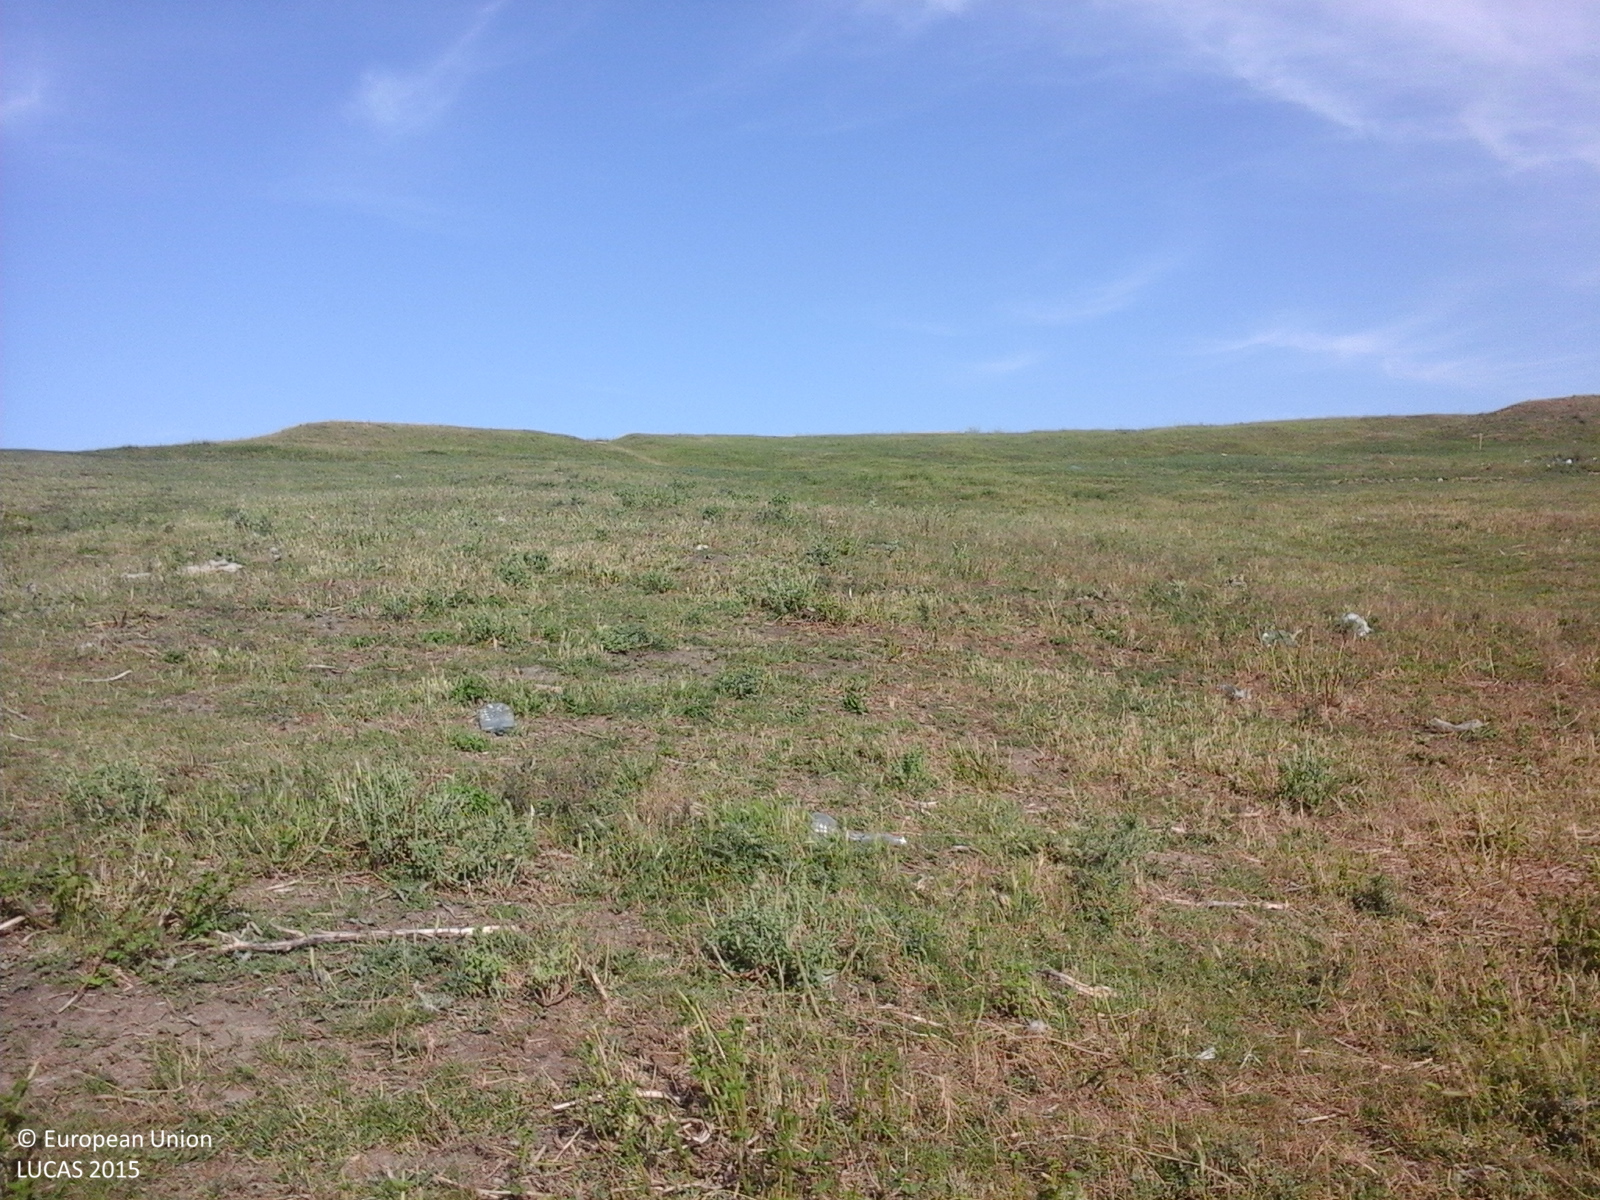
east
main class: Grassland
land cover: Grassland without tree/shrub cover
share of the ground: > 75 %
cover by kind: herbaceous plants 100 %
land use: Agriculture (excluding fallow land and kitchen gardens)
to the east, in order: Grassland without tree/shrub cover; Tracks; Grassland without tree/shrub cover; Tracks; Common wheat; Maize; Tracks; Spontaneously vegetated surfaces; Broadleaved woodland
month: June
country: RO
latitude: 47.0868
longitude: 26.9191
